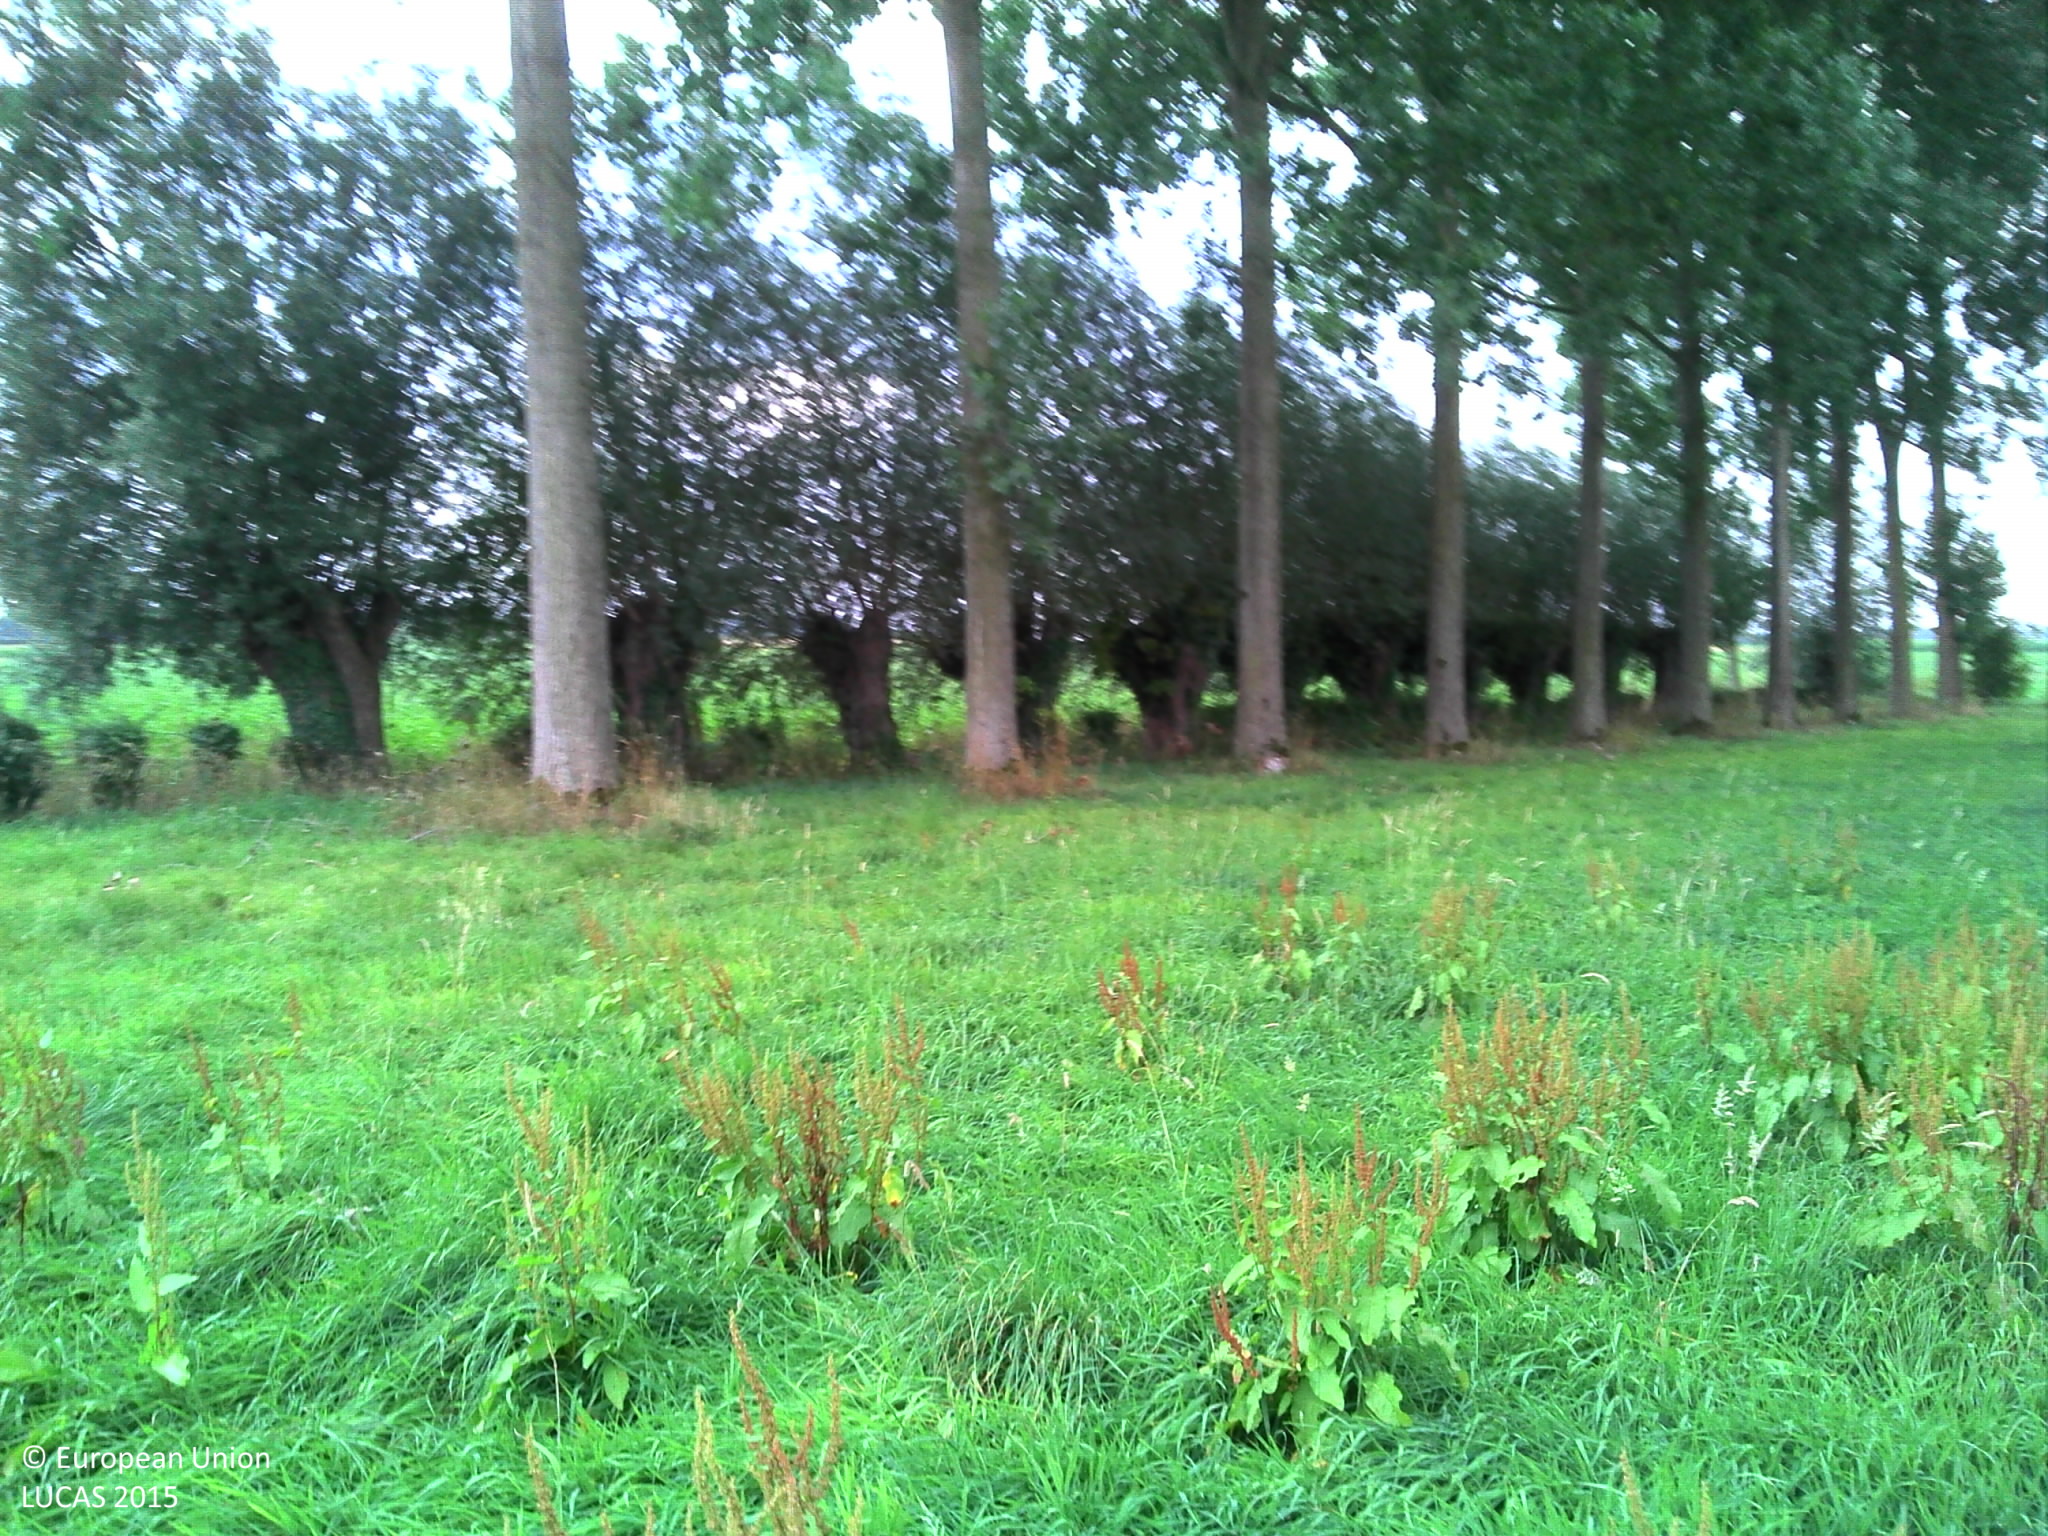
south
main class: Grassland
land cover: Grassland without tree/shrub cover
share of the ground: > 75 %
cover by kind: herbaceous plants 100 %
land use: Agriculture (excluding fallow land and kitchen gardens)
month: August
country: BE
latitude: 50.6653
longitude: 3.8108
